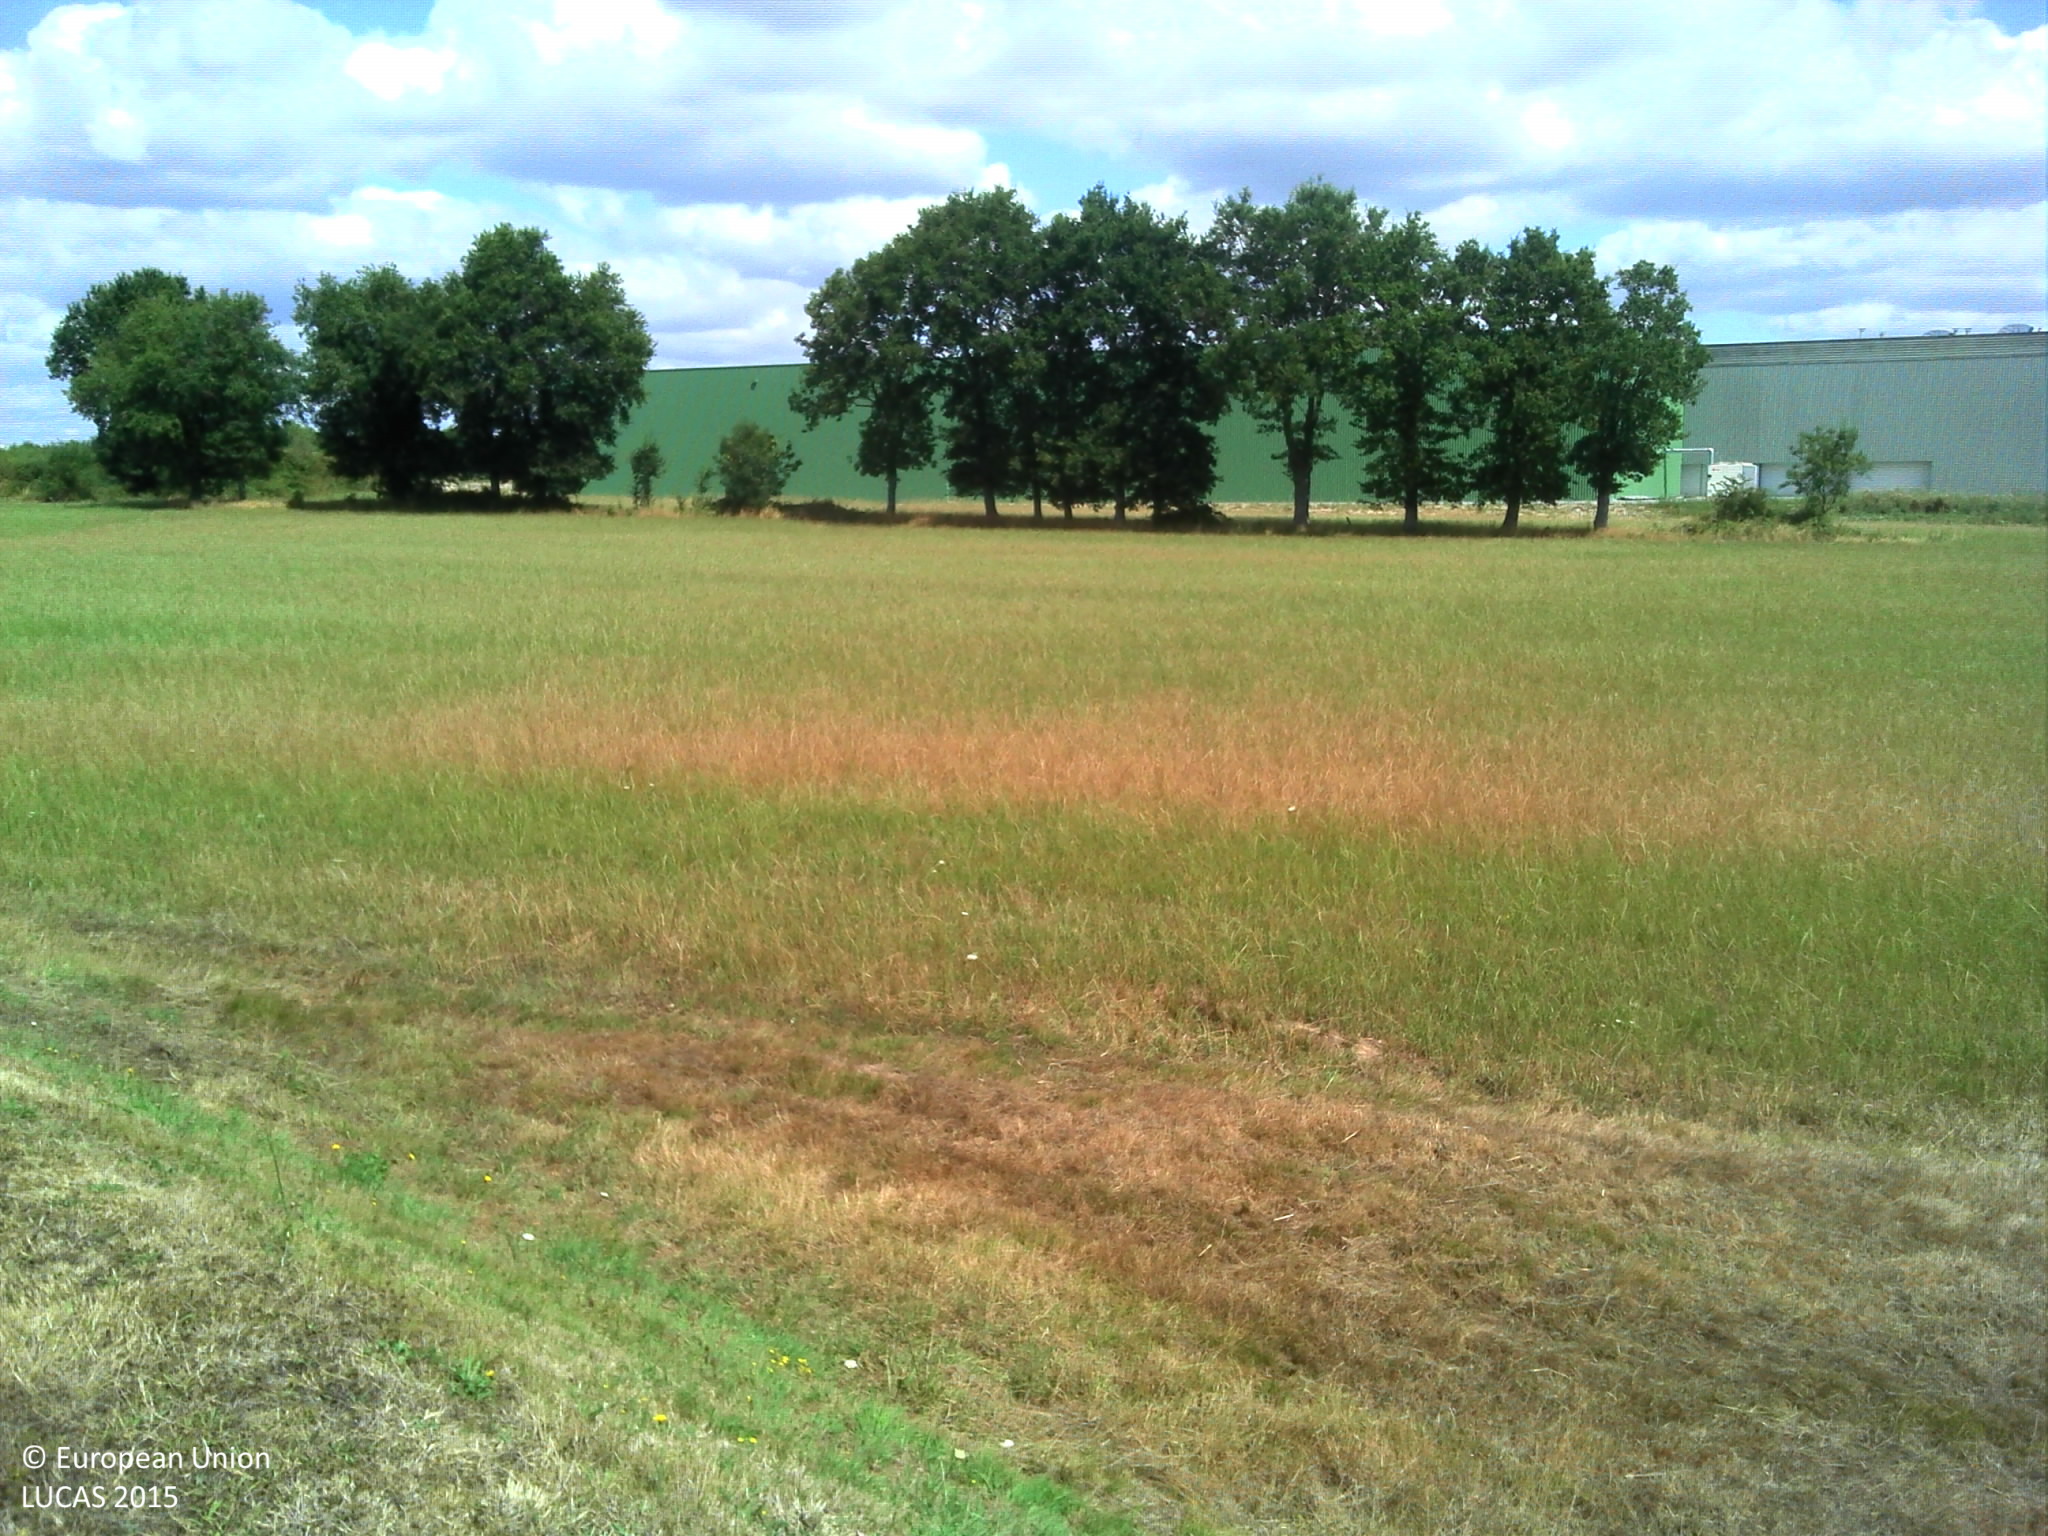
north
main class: Grassland
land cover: Grassland without tree/shrub cover
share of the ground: > 75 %
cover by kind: herbaceous plants 100 %
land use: Water supply and treatment
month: July
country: FR
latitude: 46.9879
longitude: -0.9333
